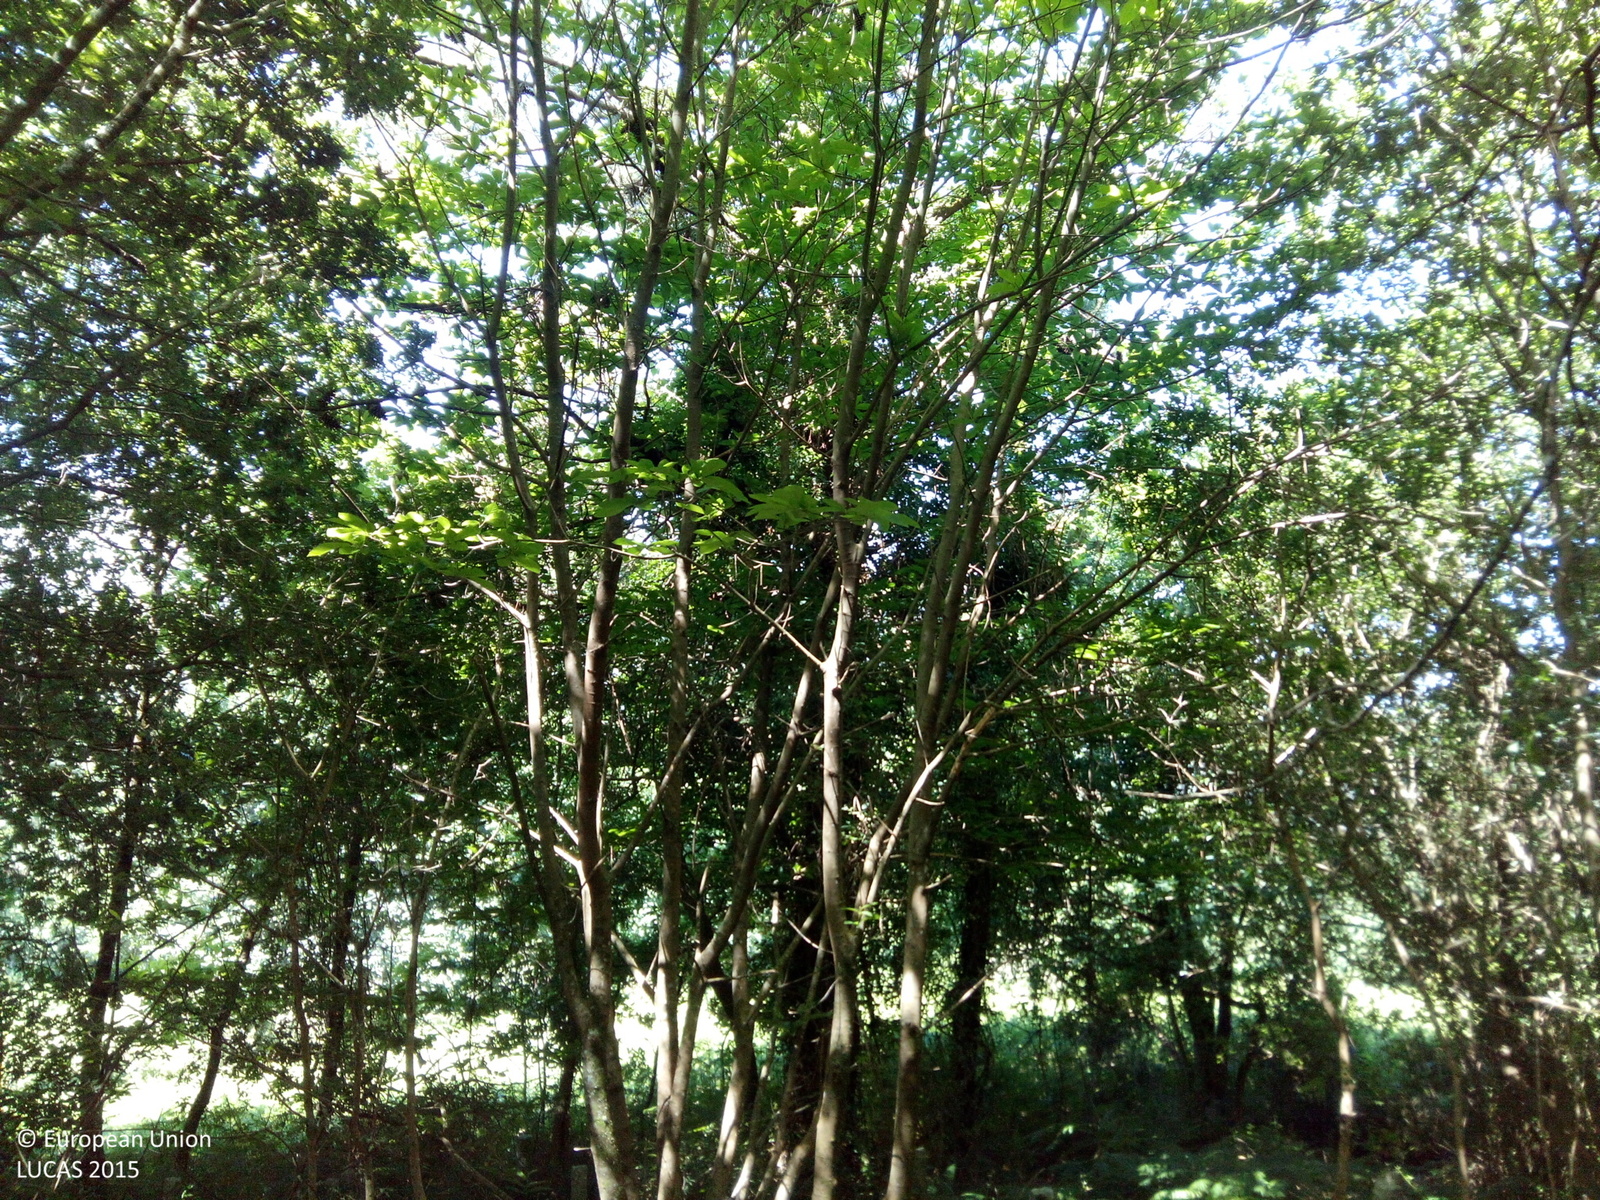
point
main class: Woodland
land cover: Broadleaved woodland
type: thermophilous deciduous forest
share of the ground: > 75 %
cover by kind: broadleaved forest trees 100 %
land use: Forestry
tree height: > 5 m
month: May
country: ES
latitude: 42.0767
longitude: -8.8005
